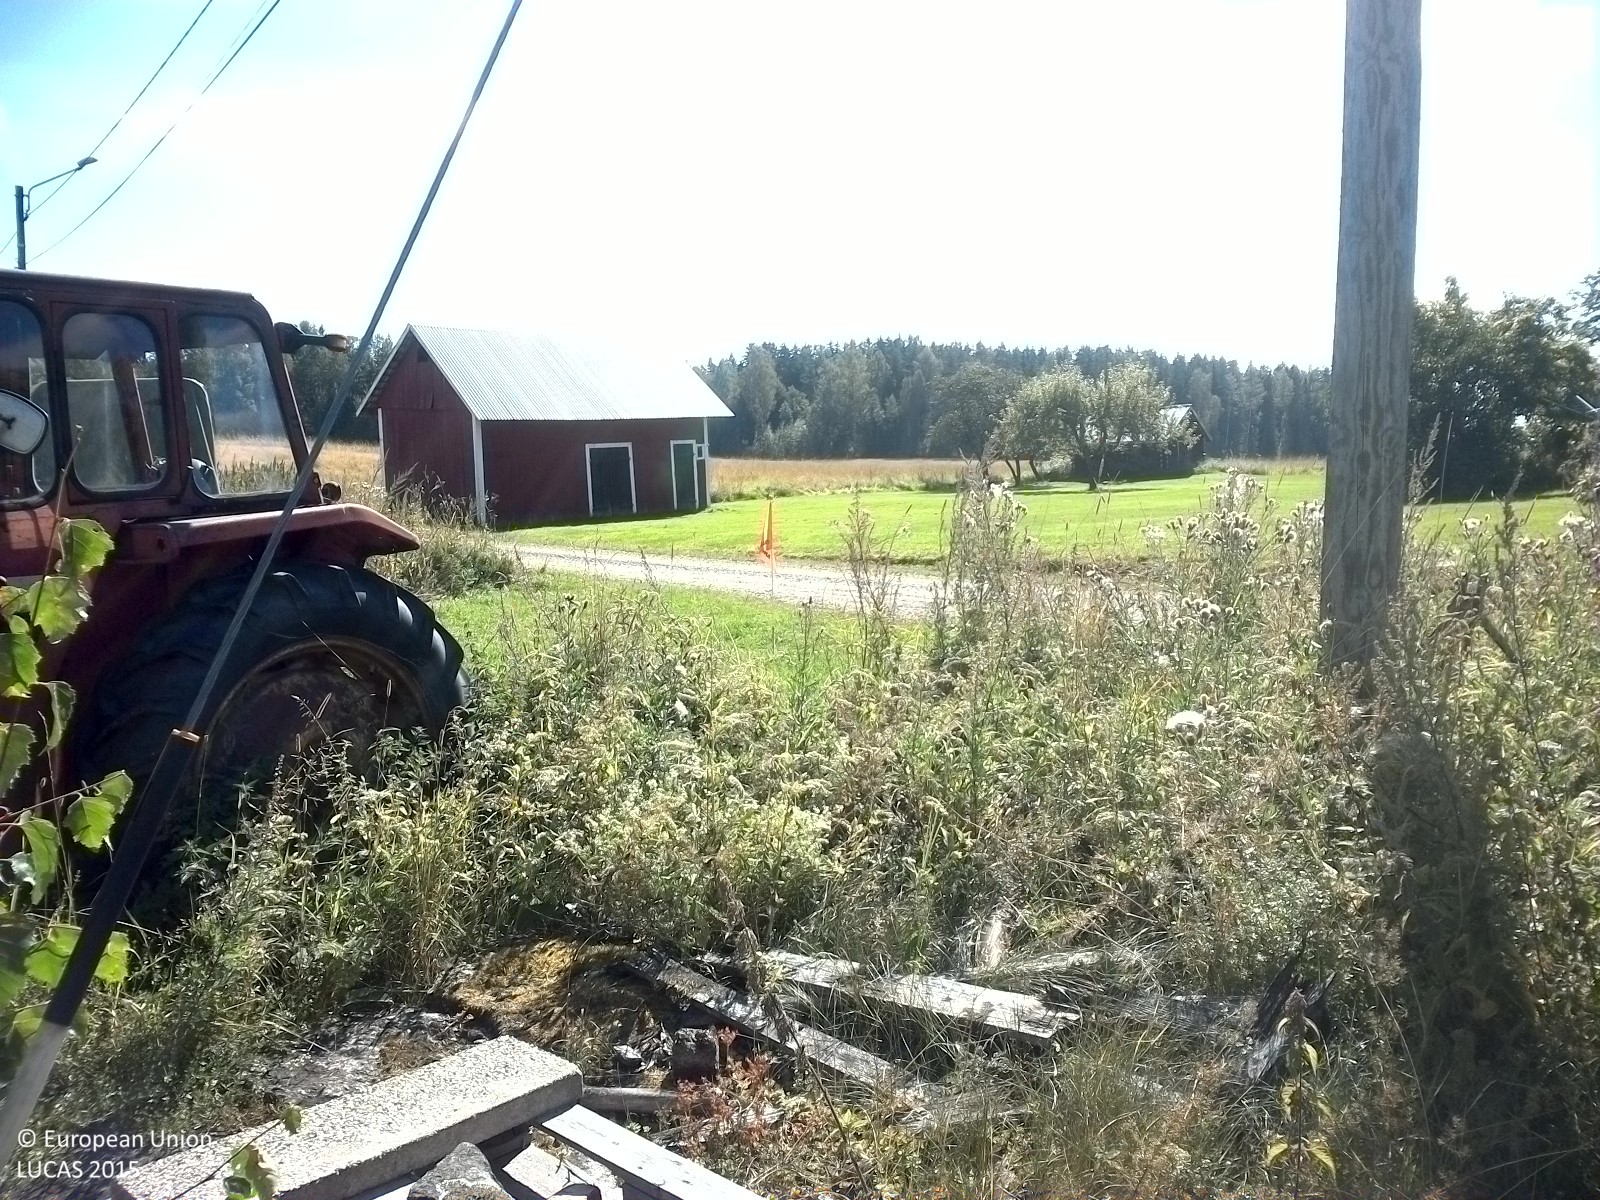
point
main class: Grassland
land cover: Spontaneously vegetated surfaces
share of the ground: > 75 %
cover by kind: herbaceous plants 100 %
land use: Residential
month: August
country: SE
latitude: 59.4702
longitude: 15.2327
